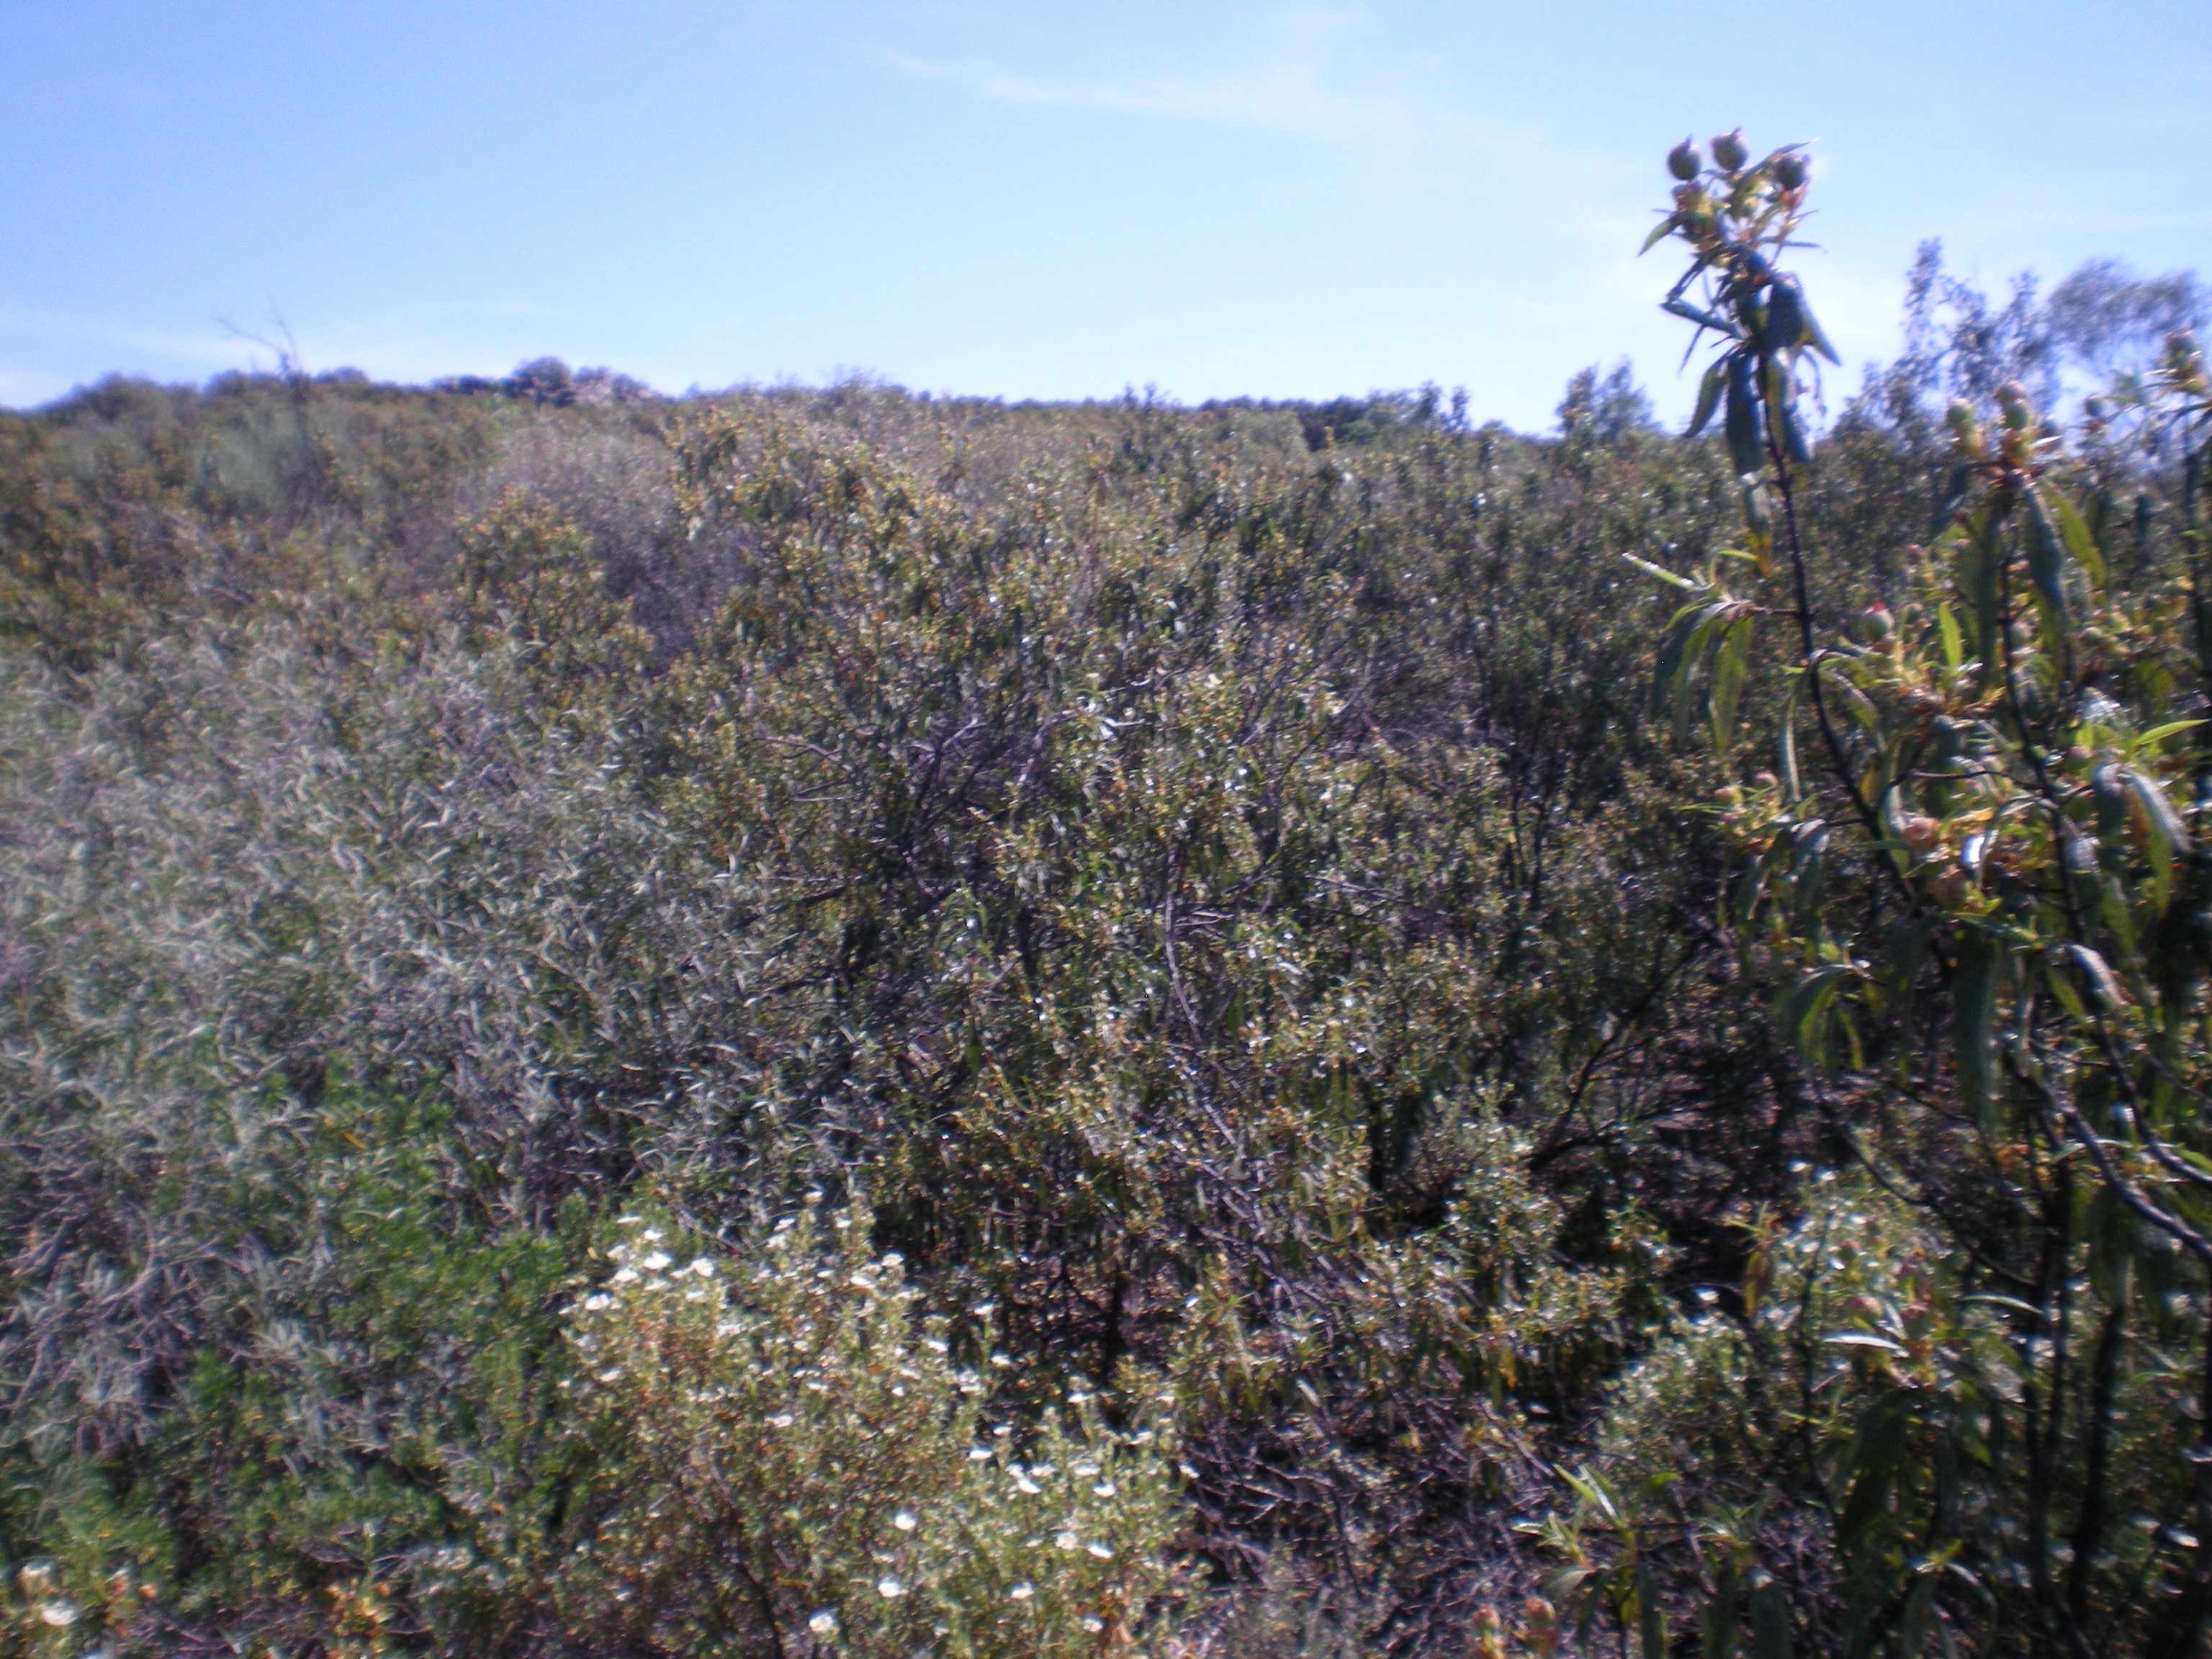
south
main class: Shrubland
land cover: Shrubland with sparse tree cover
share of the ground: > 75 %
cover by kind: shrubs 80 %, herbaceous plants 10 %, broadleaved forest trees 5 %, unconsolidated bare surface 5 %
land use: Other primary production
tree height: < 5 m
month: May
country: ES
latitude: 38.5283
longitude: -3.4638
